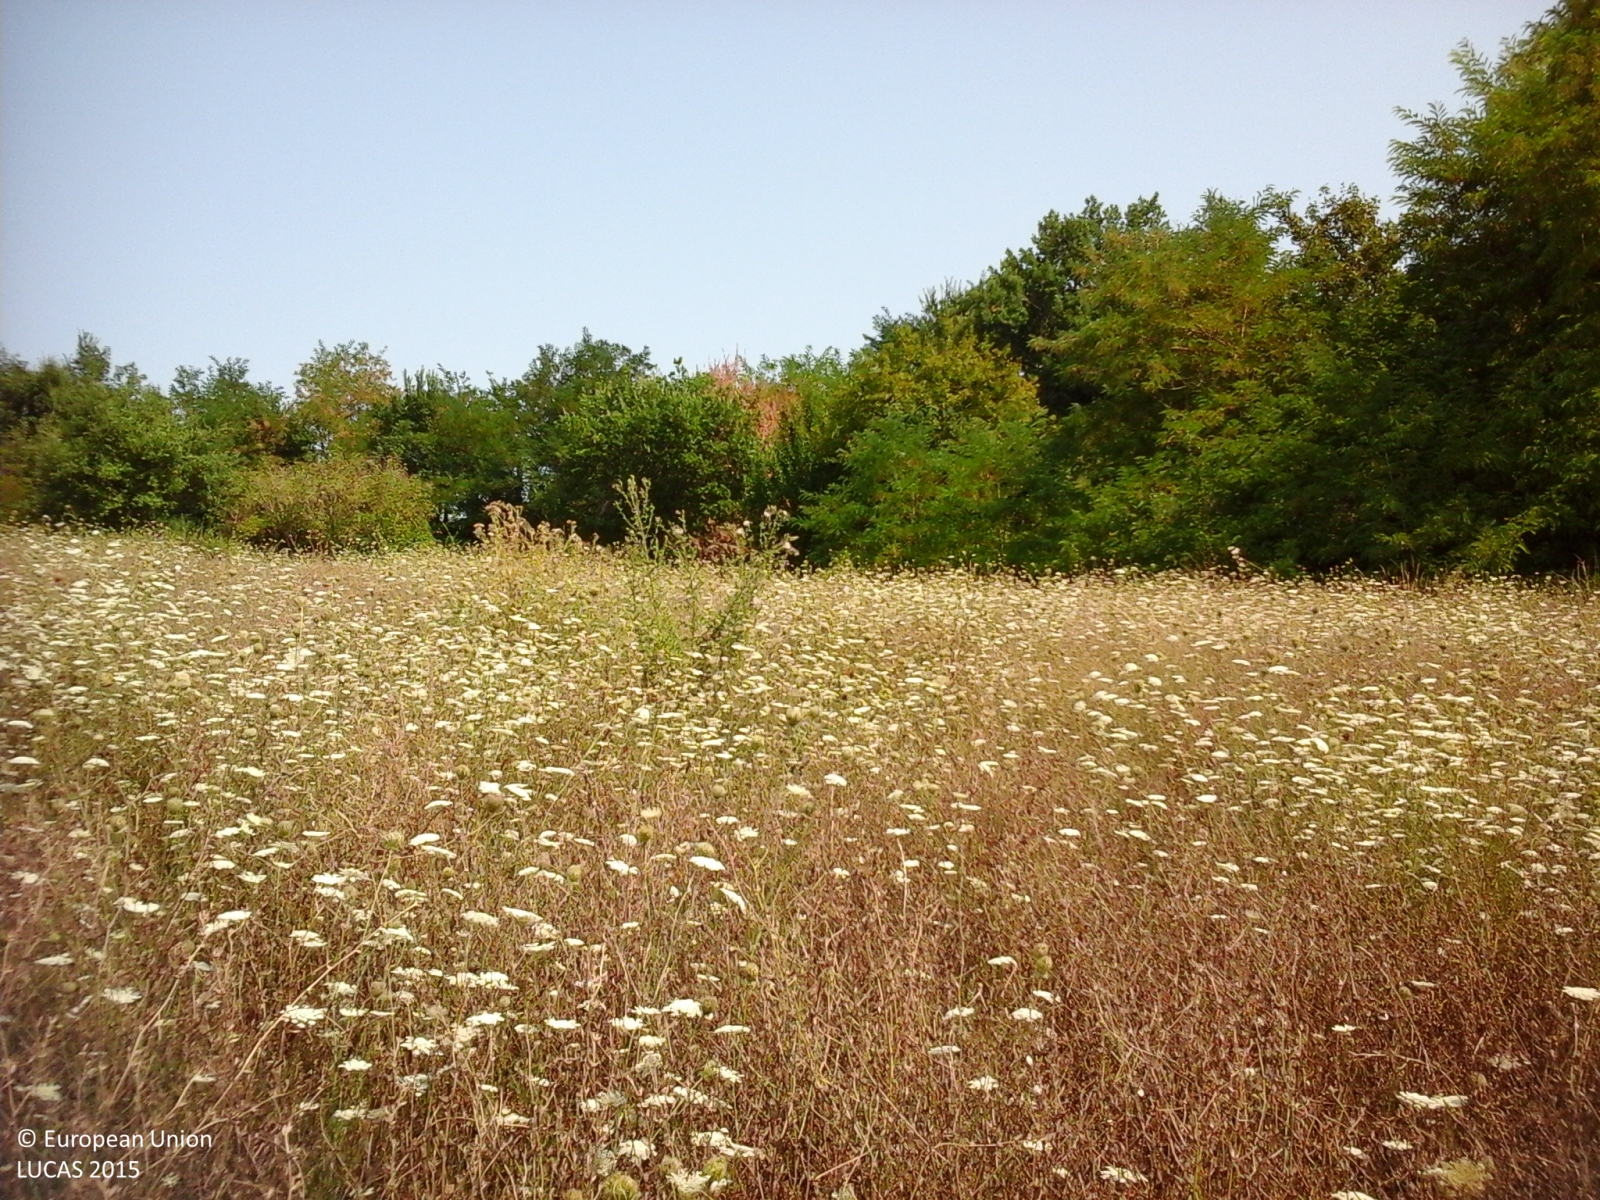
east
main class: Grassland
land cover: Spontaneously vegetated surfaces
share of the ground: > 75 %
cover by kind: herbaceous plants 100 %
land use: Fallow land
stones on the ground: < 10 %
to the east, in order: Spontaneously vegetated surfaces; Grass margins; Tracks; Grass margins; Fences; Spontaneously vegetated surfaces; Abandoned hedges; Paved roads, cycling and walking lanes; Abandoned hedges; Grassland without tree/shrub cover; Broadleaved woodland; Lucerne; Tomatoes; Other fresh vegetables
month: August
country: IT
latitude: 43.1007
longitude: 13.4678
